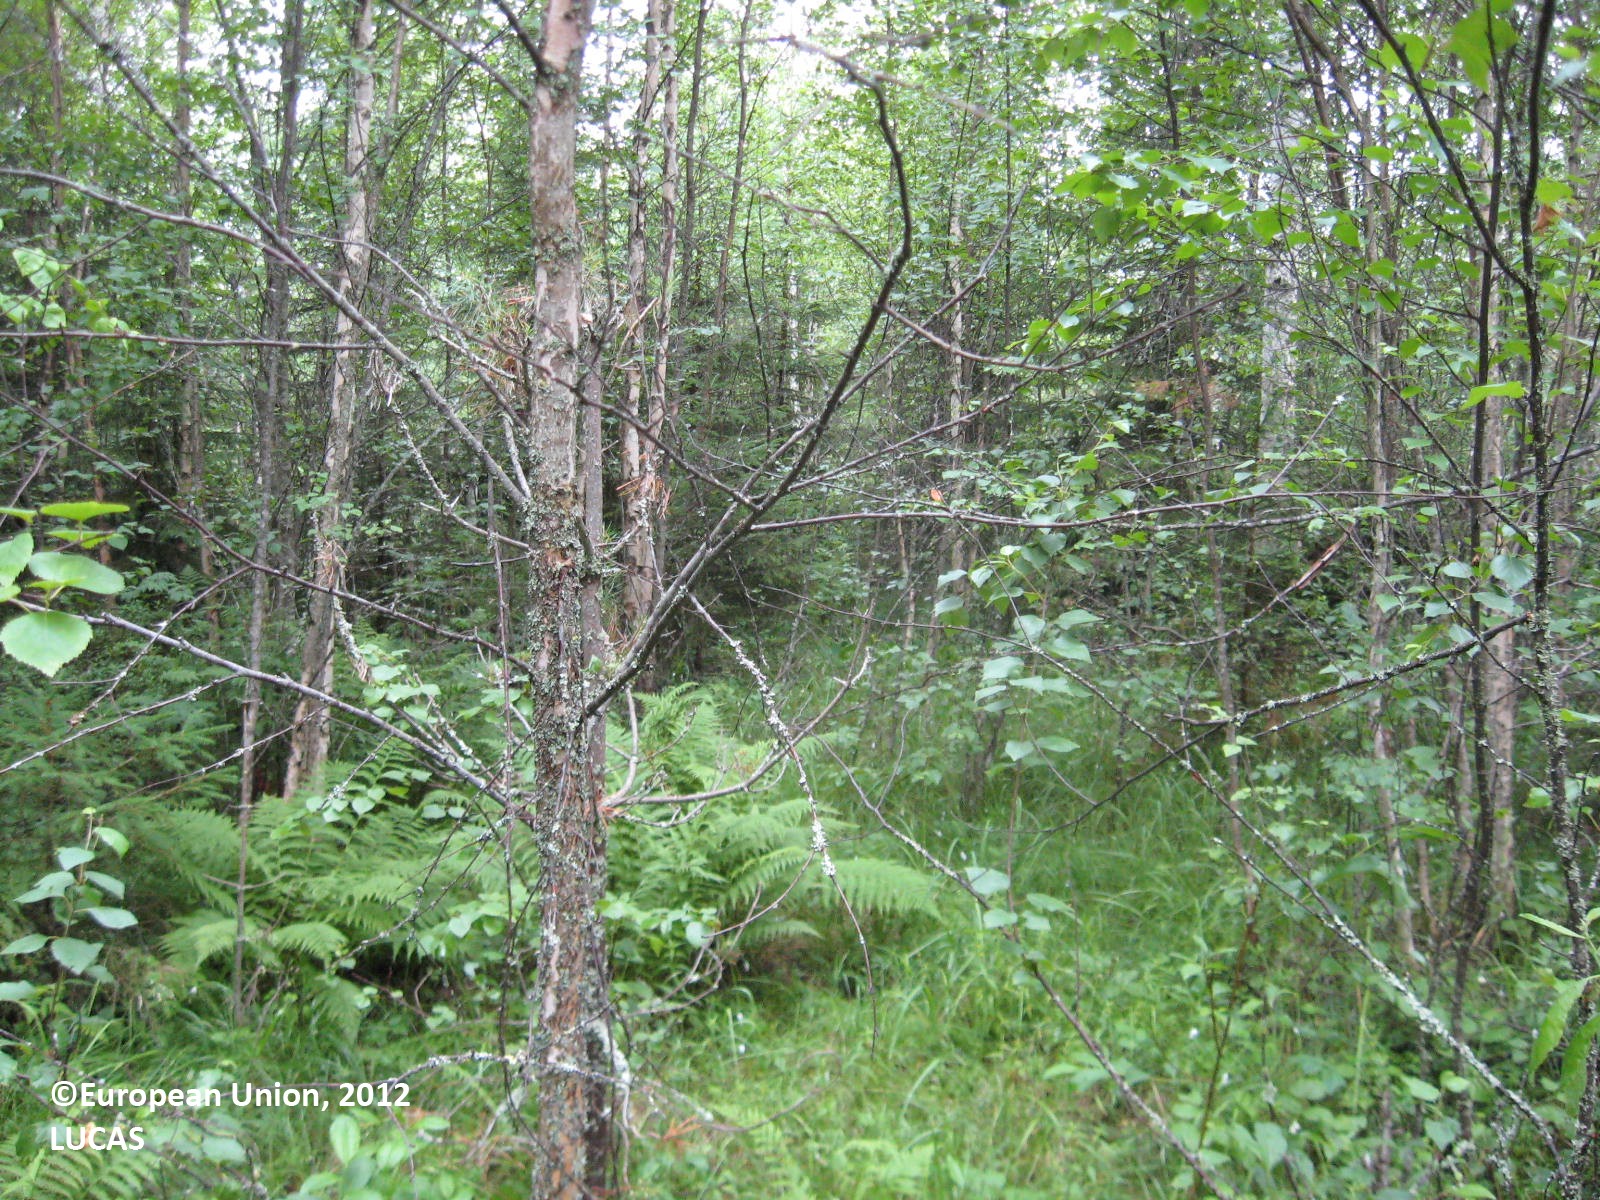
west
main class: Woodland
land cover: Other mixed woodland
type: boreal forest
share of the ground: > 75 %
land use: Forestry
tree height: > 5 m
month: July
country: FI
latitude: 62.3942
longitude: 21.6719
